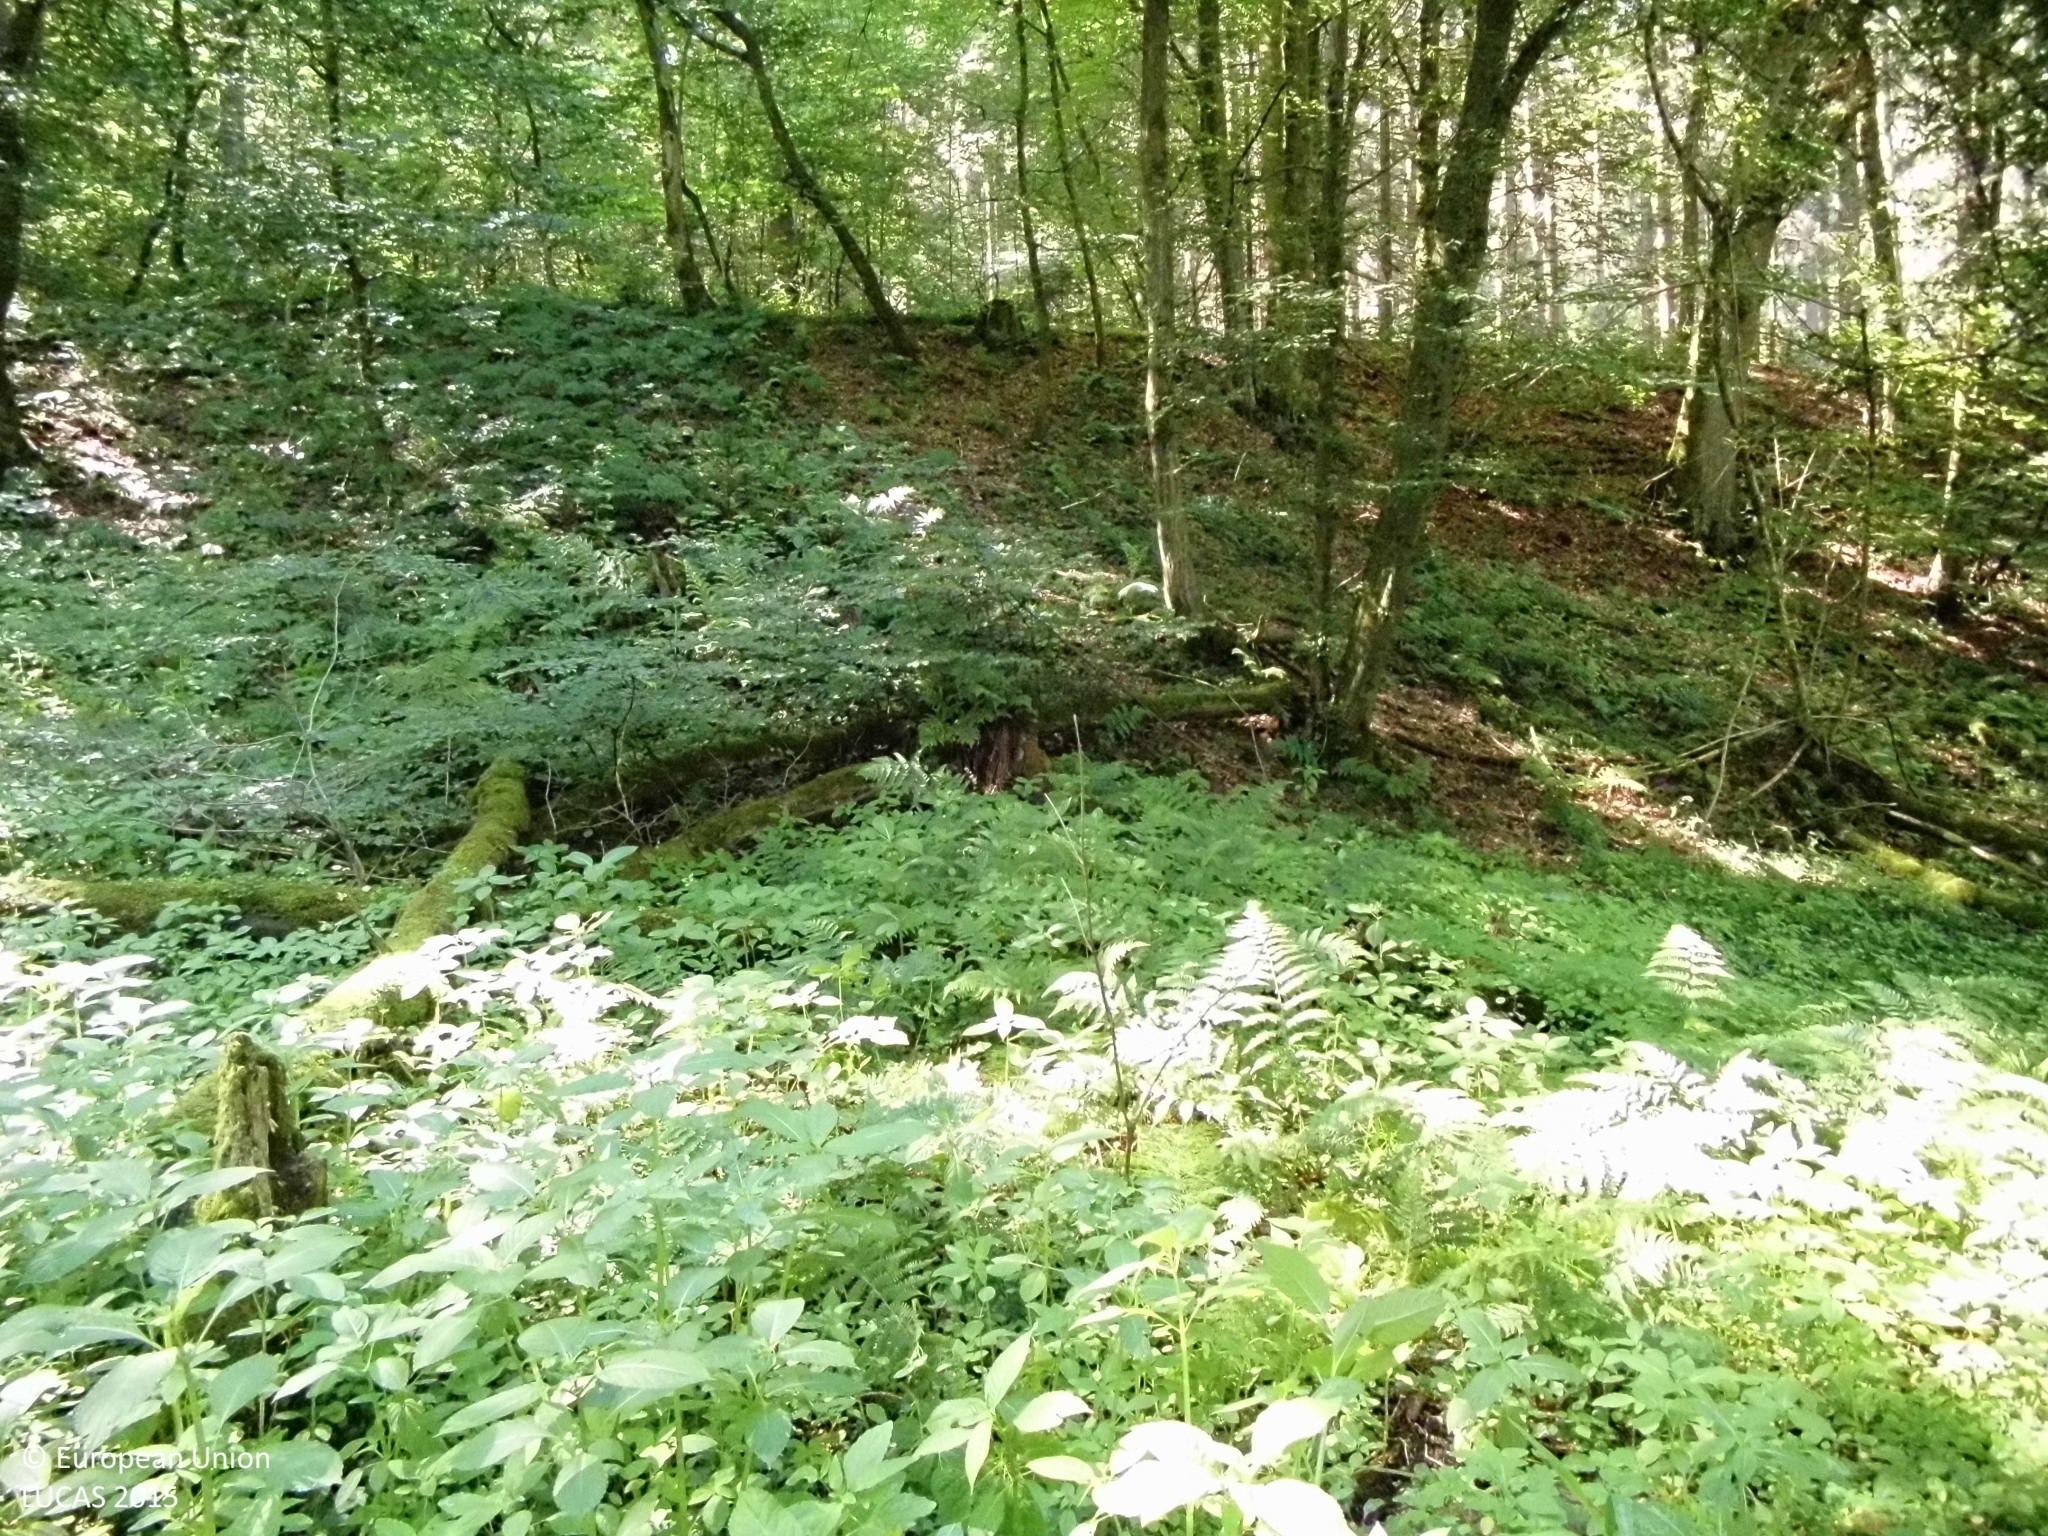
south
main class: Woodland
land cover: Broadleaved woodland
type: mesophytic deciduous forest
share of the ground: > 75 %
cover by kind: broadleaved forest trees 85 %, herbaceous plants 15 %
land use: Forestry
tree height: > 5 m
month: June
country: DE
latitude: 50.9108
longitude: 7.4260
